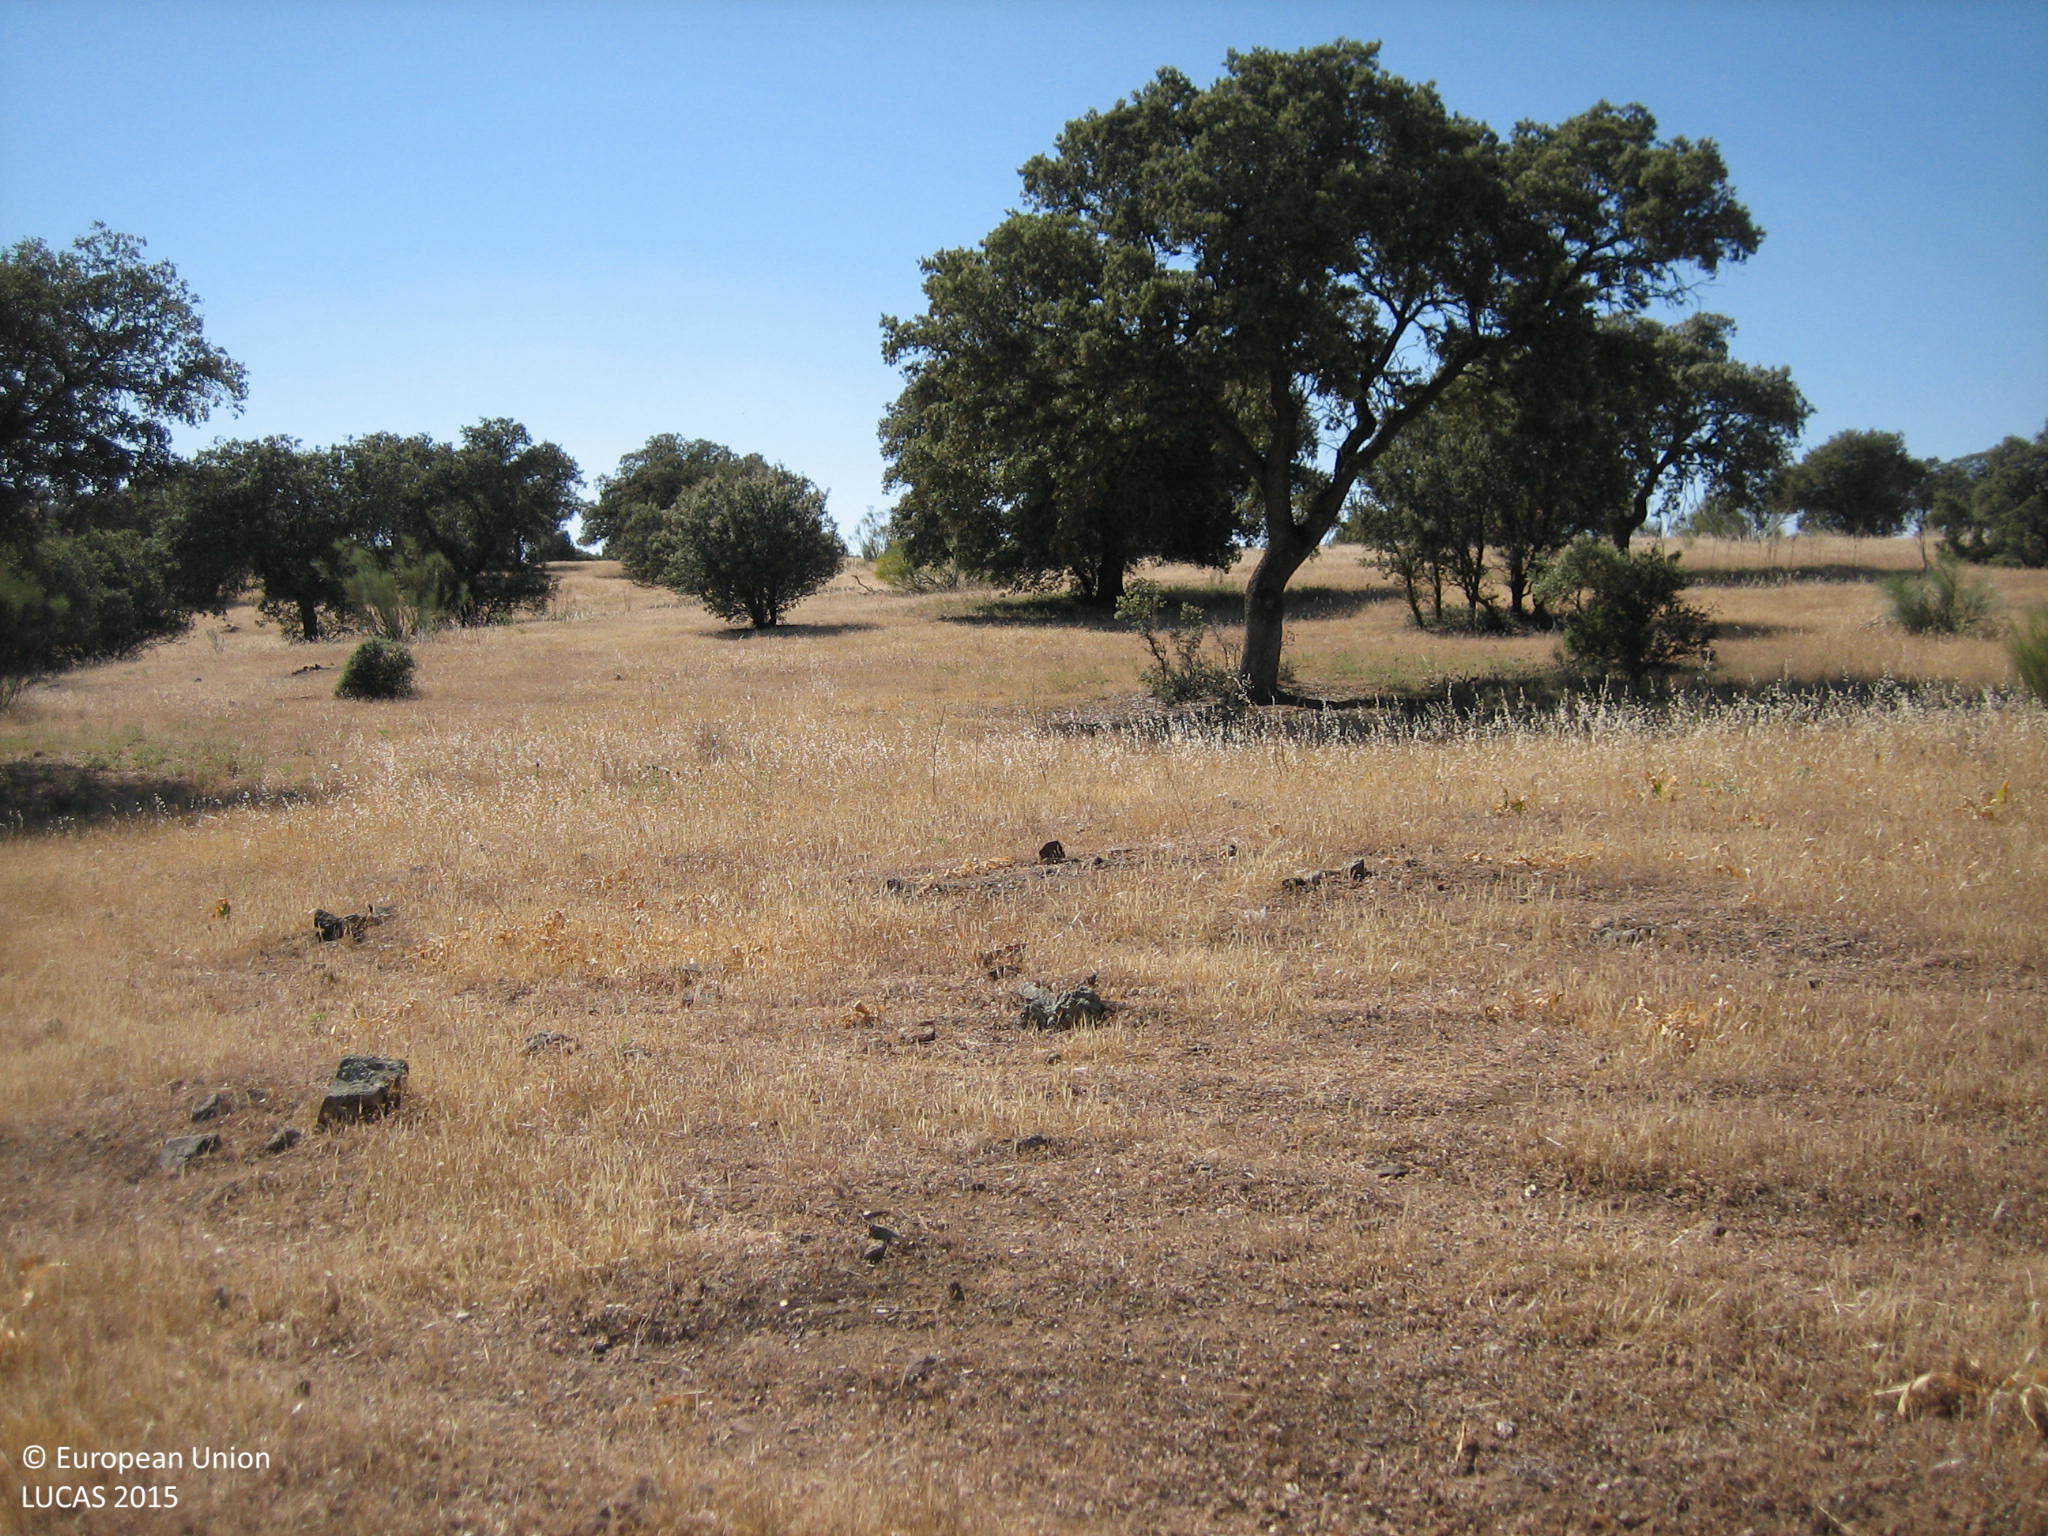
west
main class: Woodland
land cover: Broadleaved woodland
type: broadleaved evergreen forest
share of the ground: 10 - 25 %
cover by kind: herbaceous plants 85 %, broadleaved forest trees 15 %
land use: Forestry
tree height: > 5 m
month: May
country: ES
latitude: 38.5103
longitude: -3.9705
